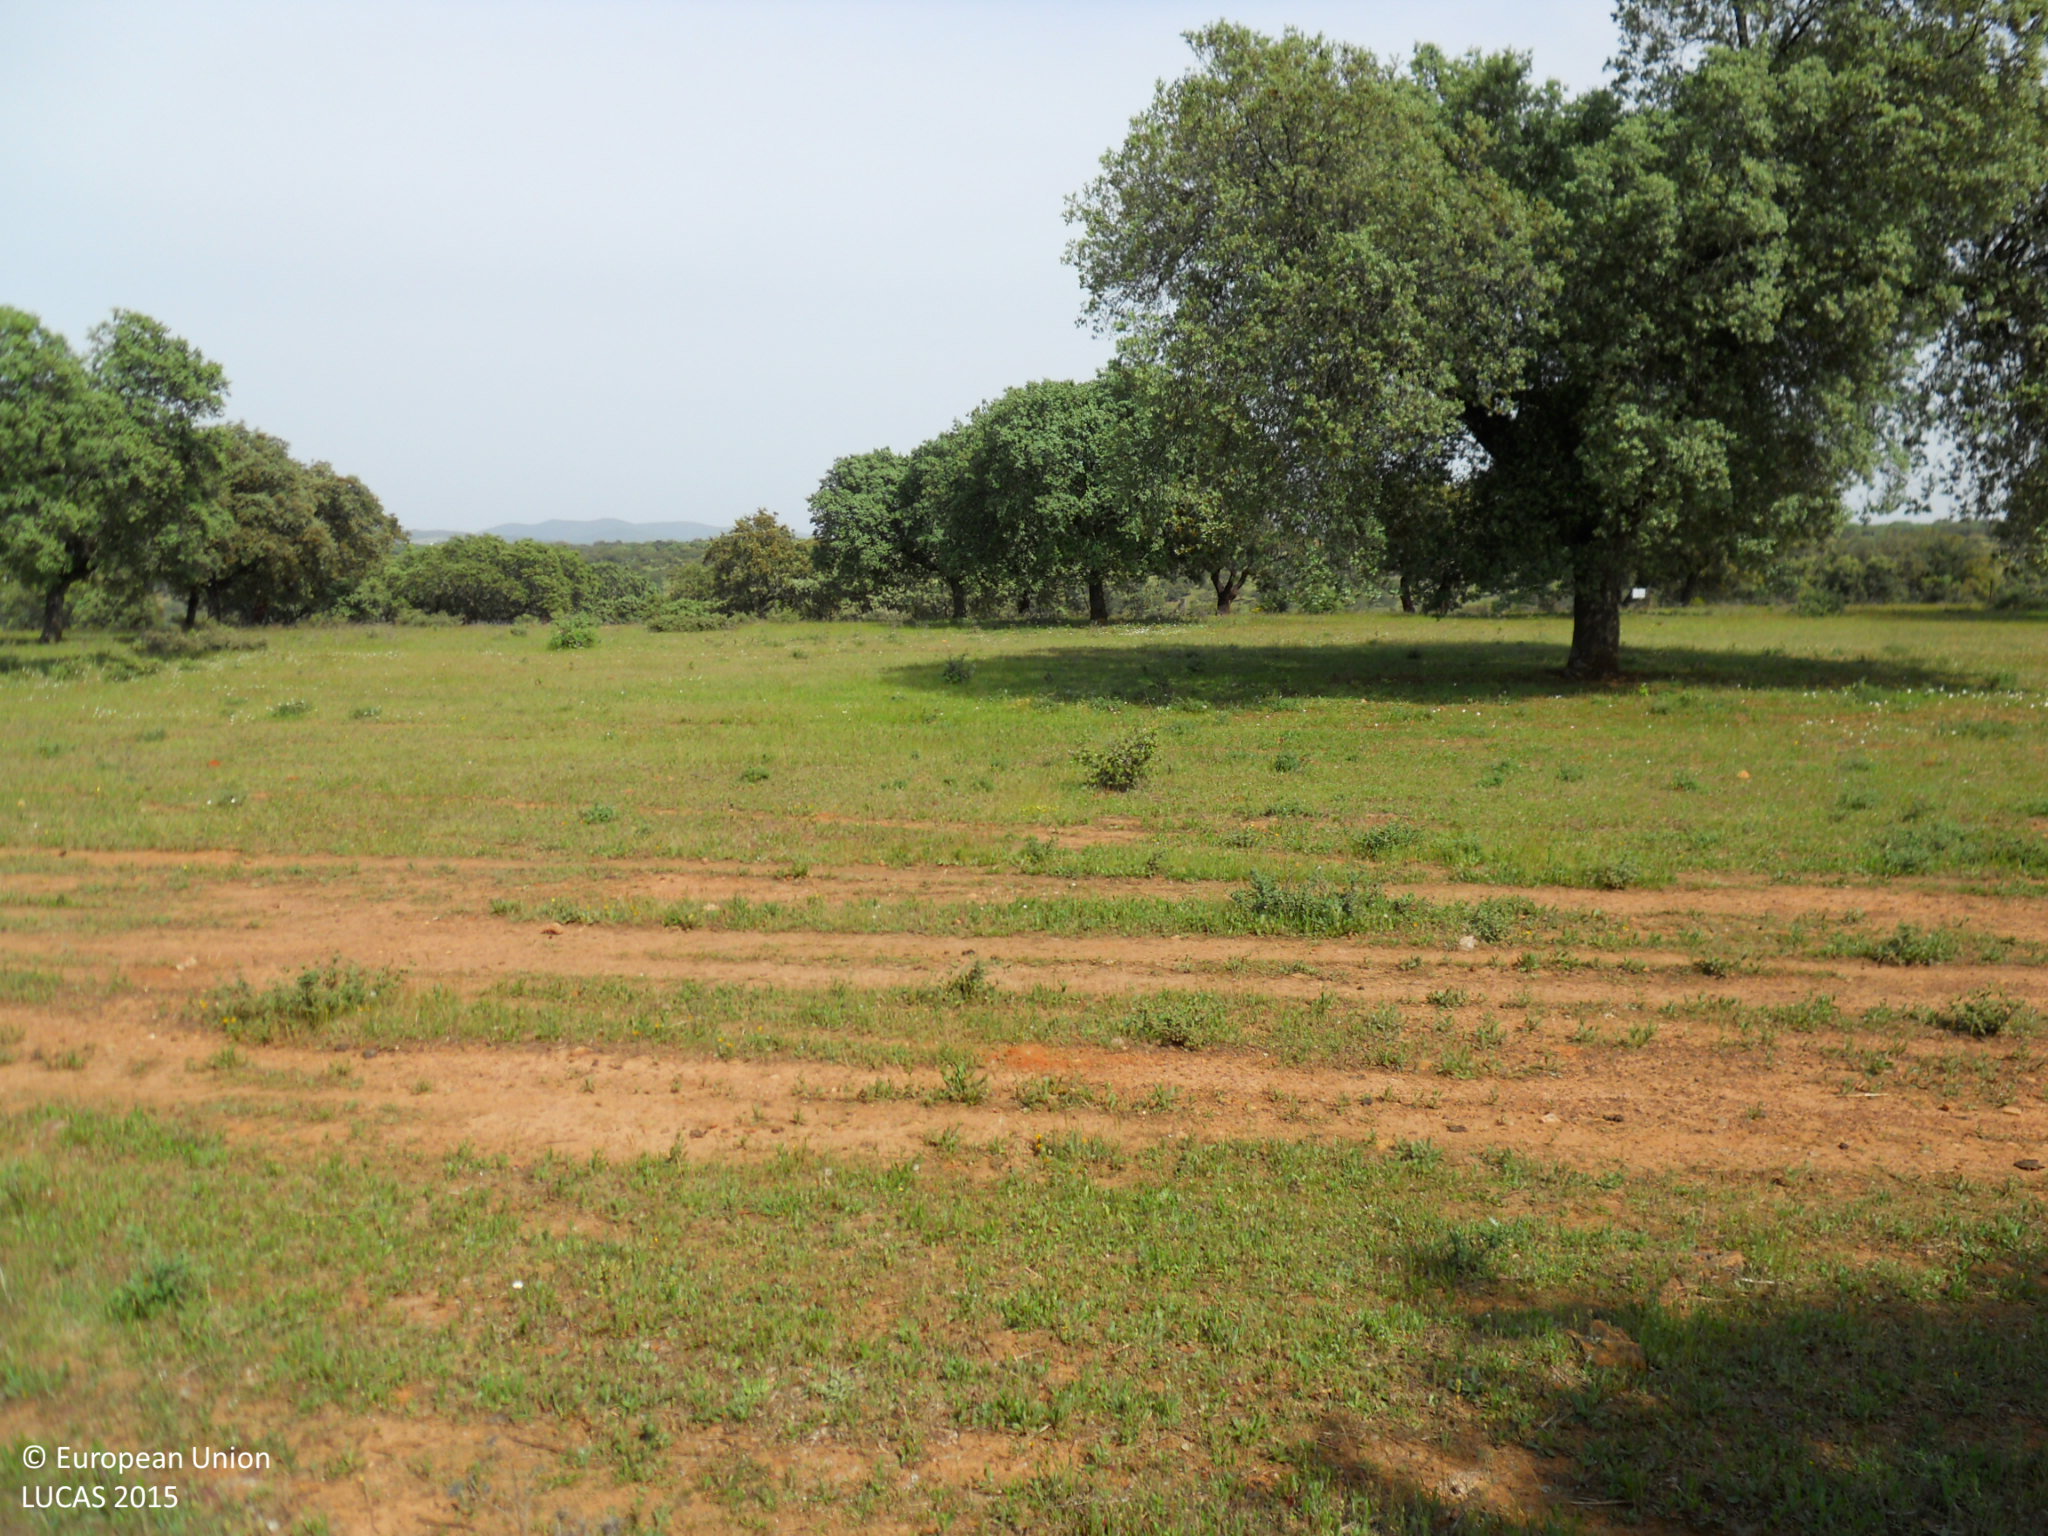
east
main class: Woodland
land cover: Broadleaved woodland
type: broadleaved evergreen forest
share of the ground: 25 - 50 %
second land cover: Grassland without tree/shrub cover
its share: > 75 %
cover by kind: herbaceous plants 75 %, broadleaved forest trees 25 %
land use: Forestry
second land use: Agriculture (excluding fallow land and kitchen gardens)
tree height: > 5 m
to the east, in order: Broadleaved woodland; Grassland without tree/shrub cover; Fences; Broadleaved woodland; Tracks; Other bare soil; Paved roads, cycling and walking lanes
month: April
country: ES
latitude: 39.1408
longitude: -6.3636
